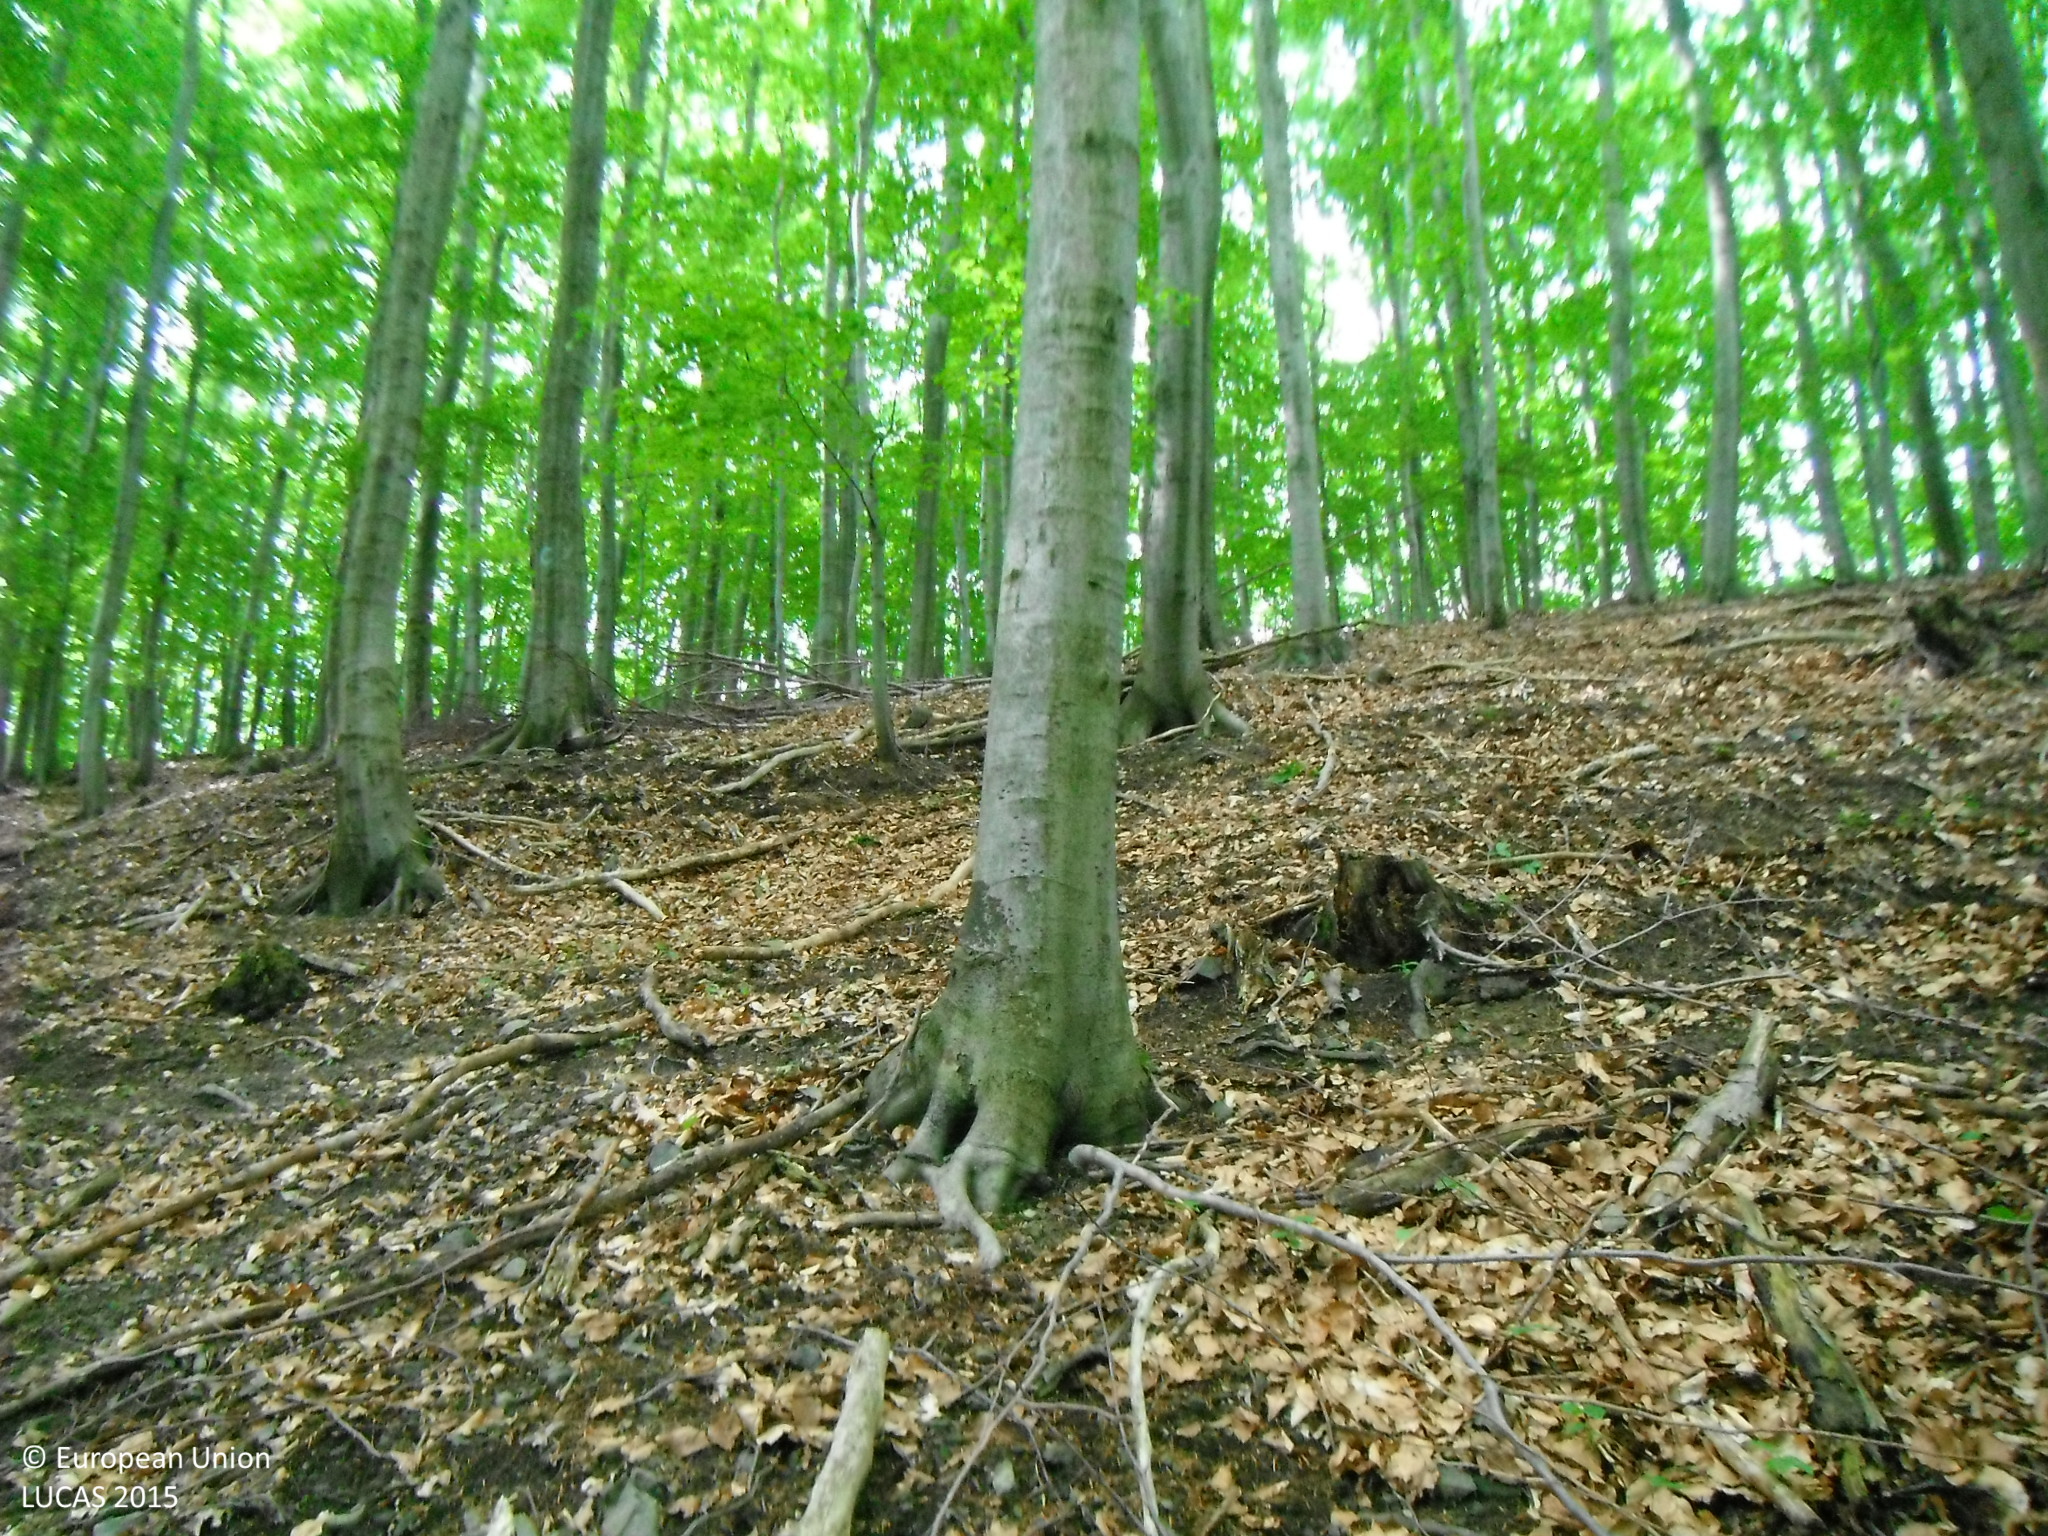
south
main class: Woodland
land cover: Broadleaved woodland
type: mountainous beech forest
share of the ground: > 75 %
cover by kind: broadleaved forest trees 100 %
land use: Forestry
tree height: > 5 m
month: May
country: SK
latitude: 48.4029
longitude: 17.2087
